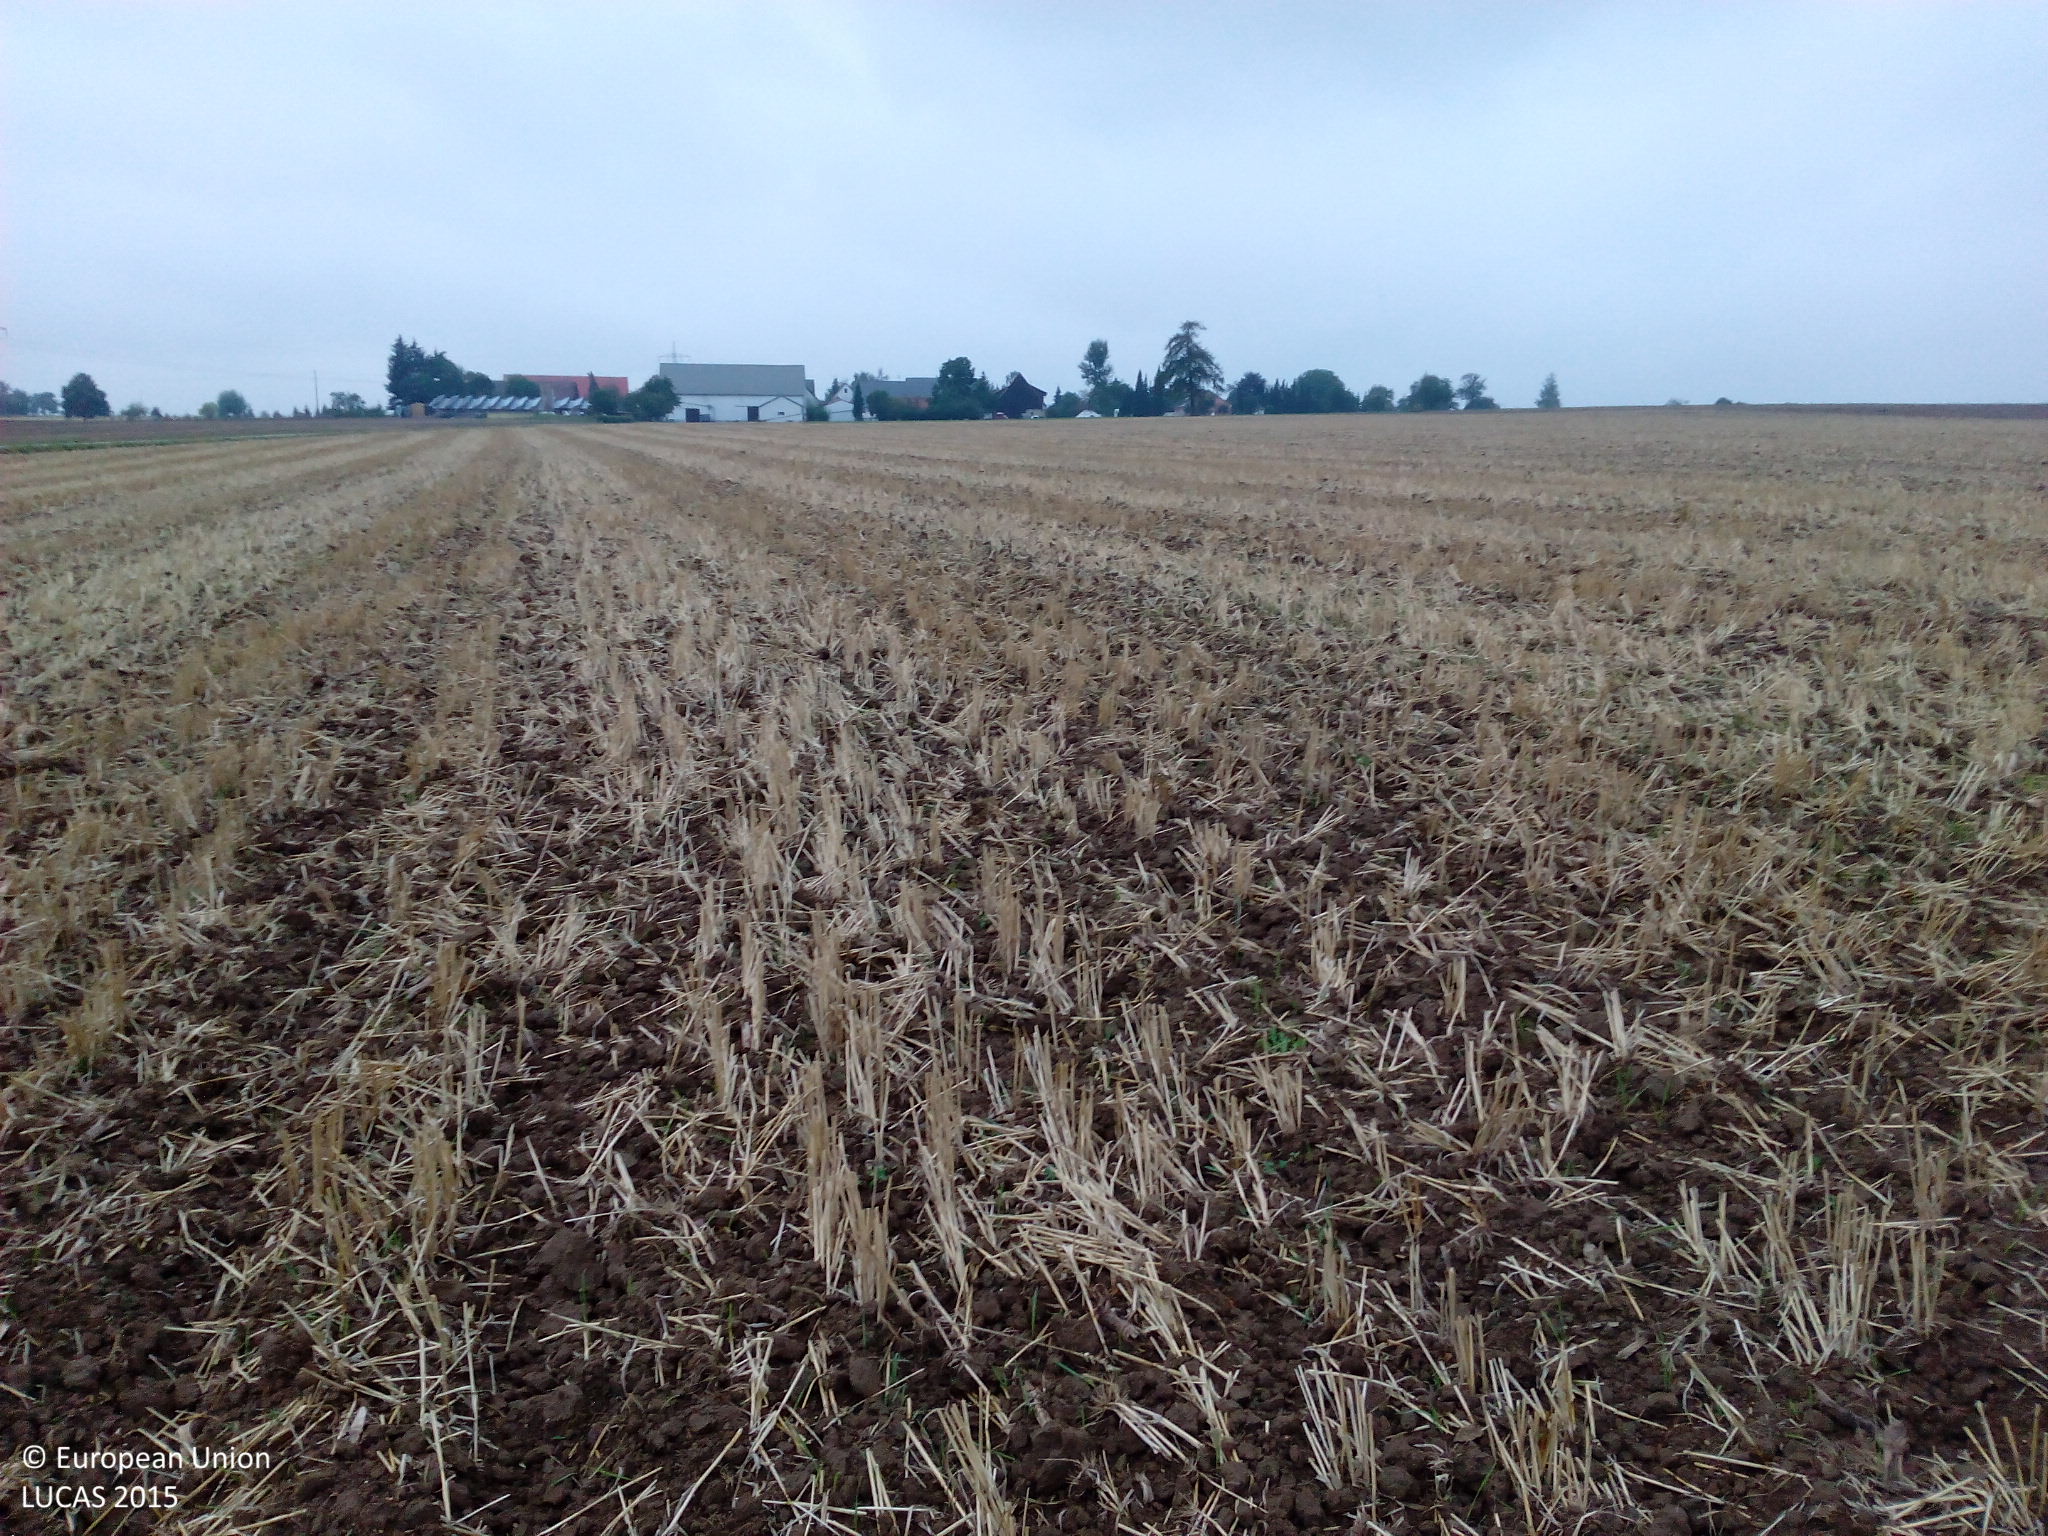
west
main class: Cropland
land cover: Common wheat
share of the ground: 25 - 50 %
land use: Agriculture (excluding fallow land and kitchen gardens)
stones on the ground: < 10 %
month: August
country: DE
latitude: 48.4934
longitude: 9.9594
